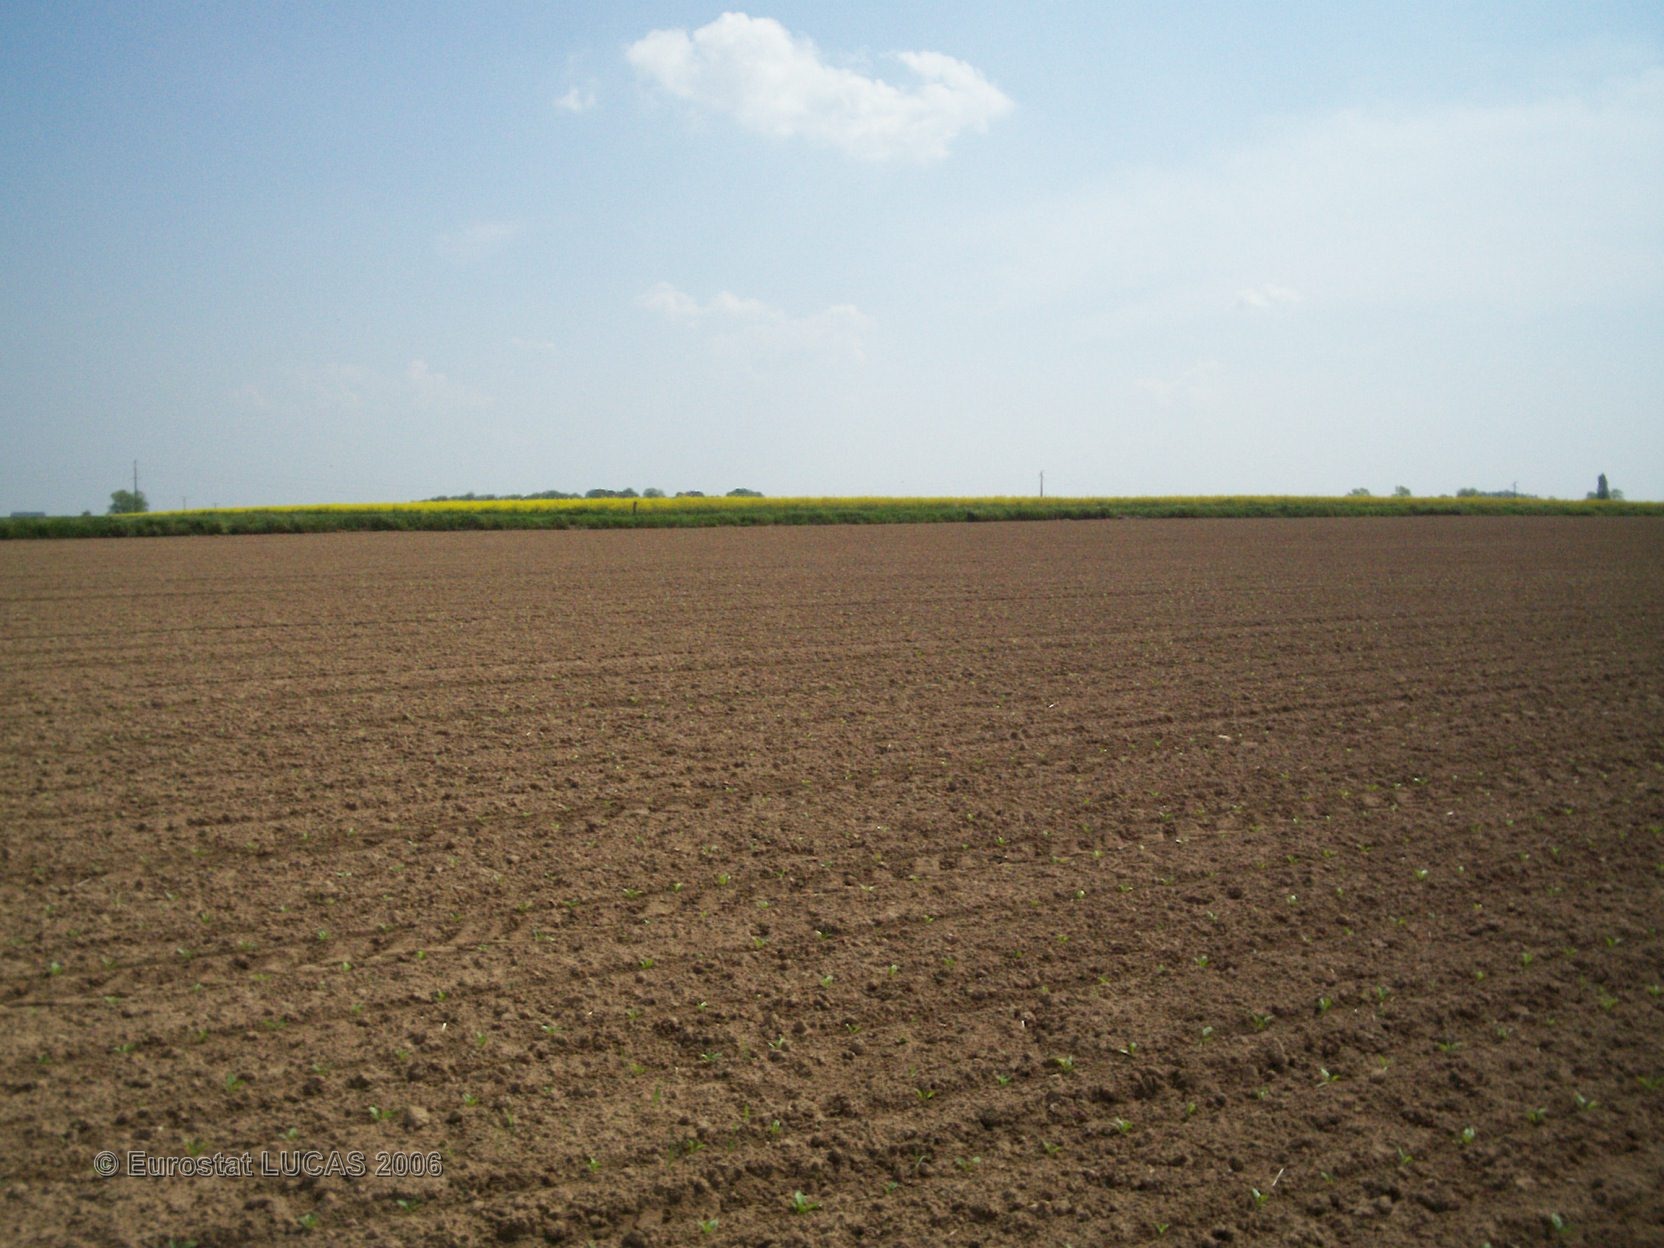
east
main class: Cropland
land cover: Sugar beet
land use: Agriculture (excluding fallow land and kitchen gardens)
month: May
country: FR
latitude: 49.1931
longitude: 0.5471
